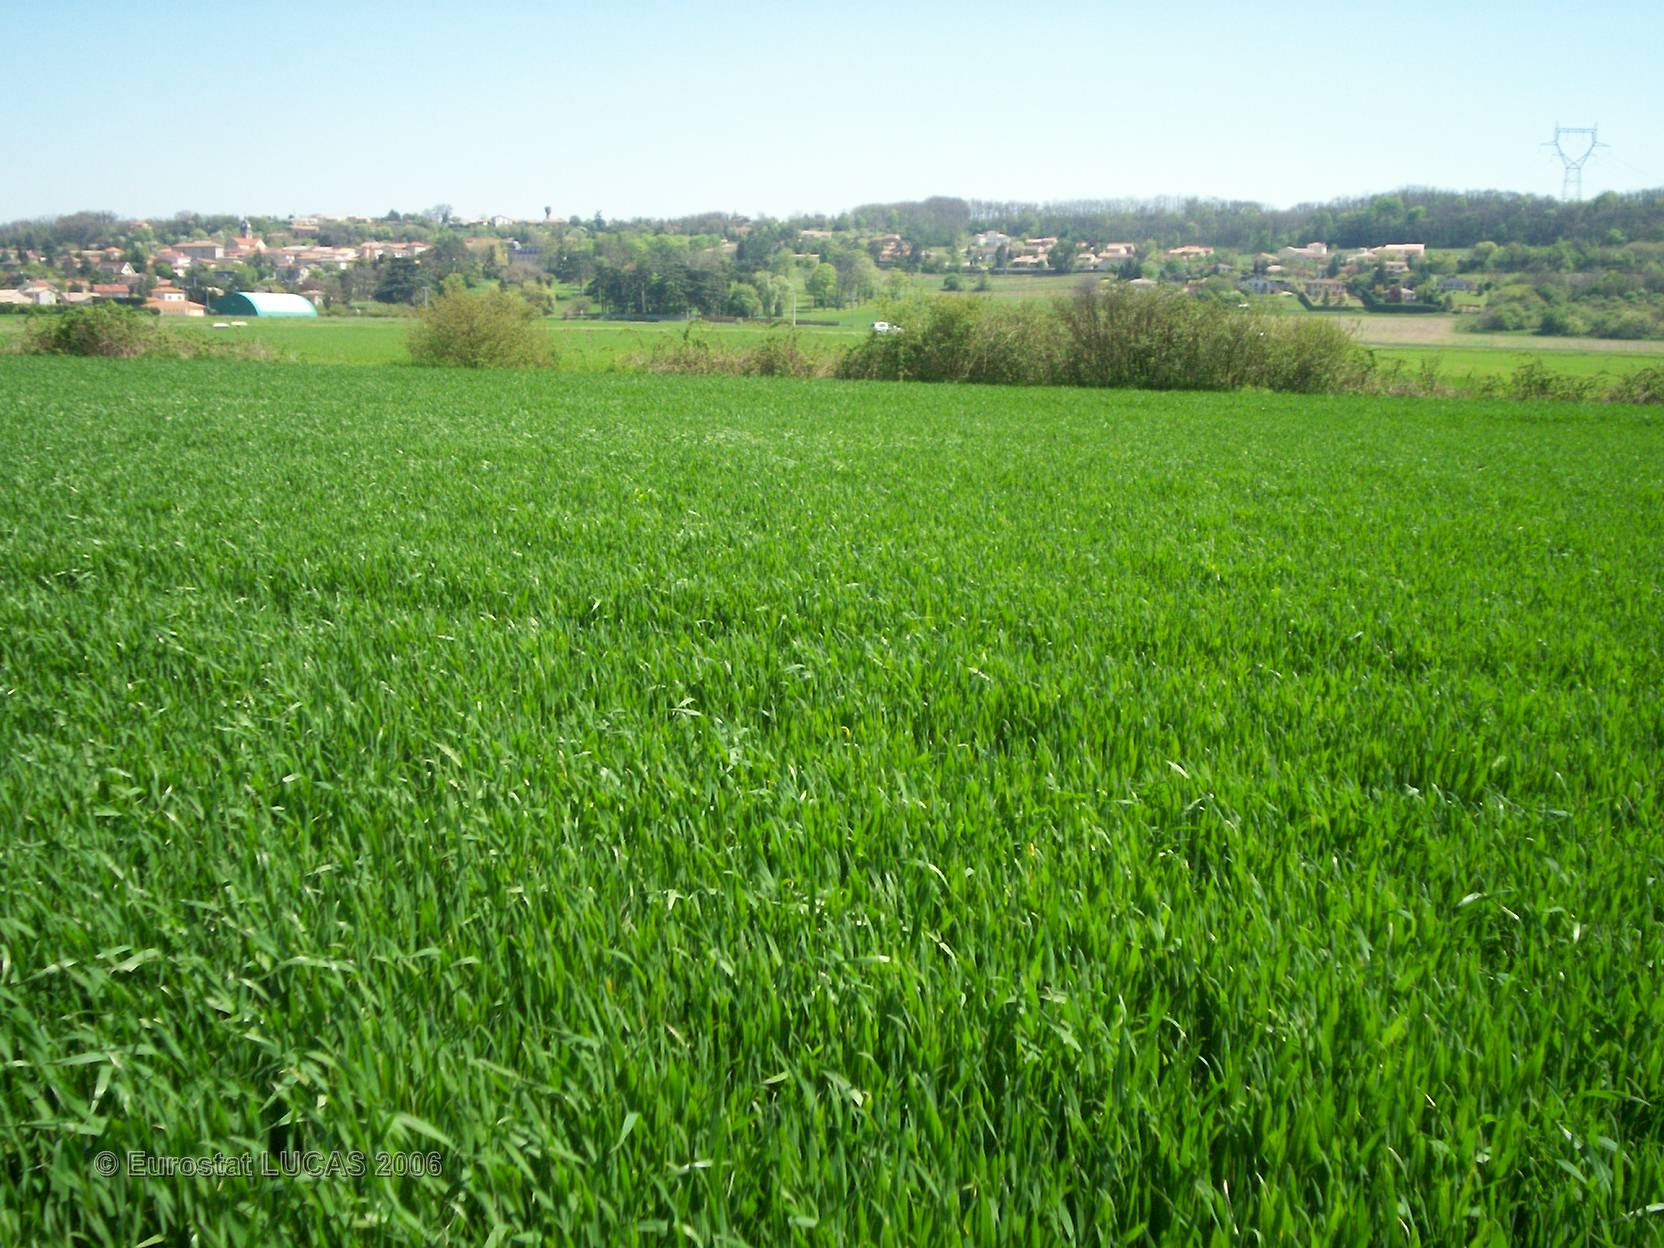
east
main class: Cropland
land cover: Triticale
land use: Agriculture (excluding fallow land and kitchen gardens)
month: April
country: FR
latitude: 45.4113
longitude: 4.7783
